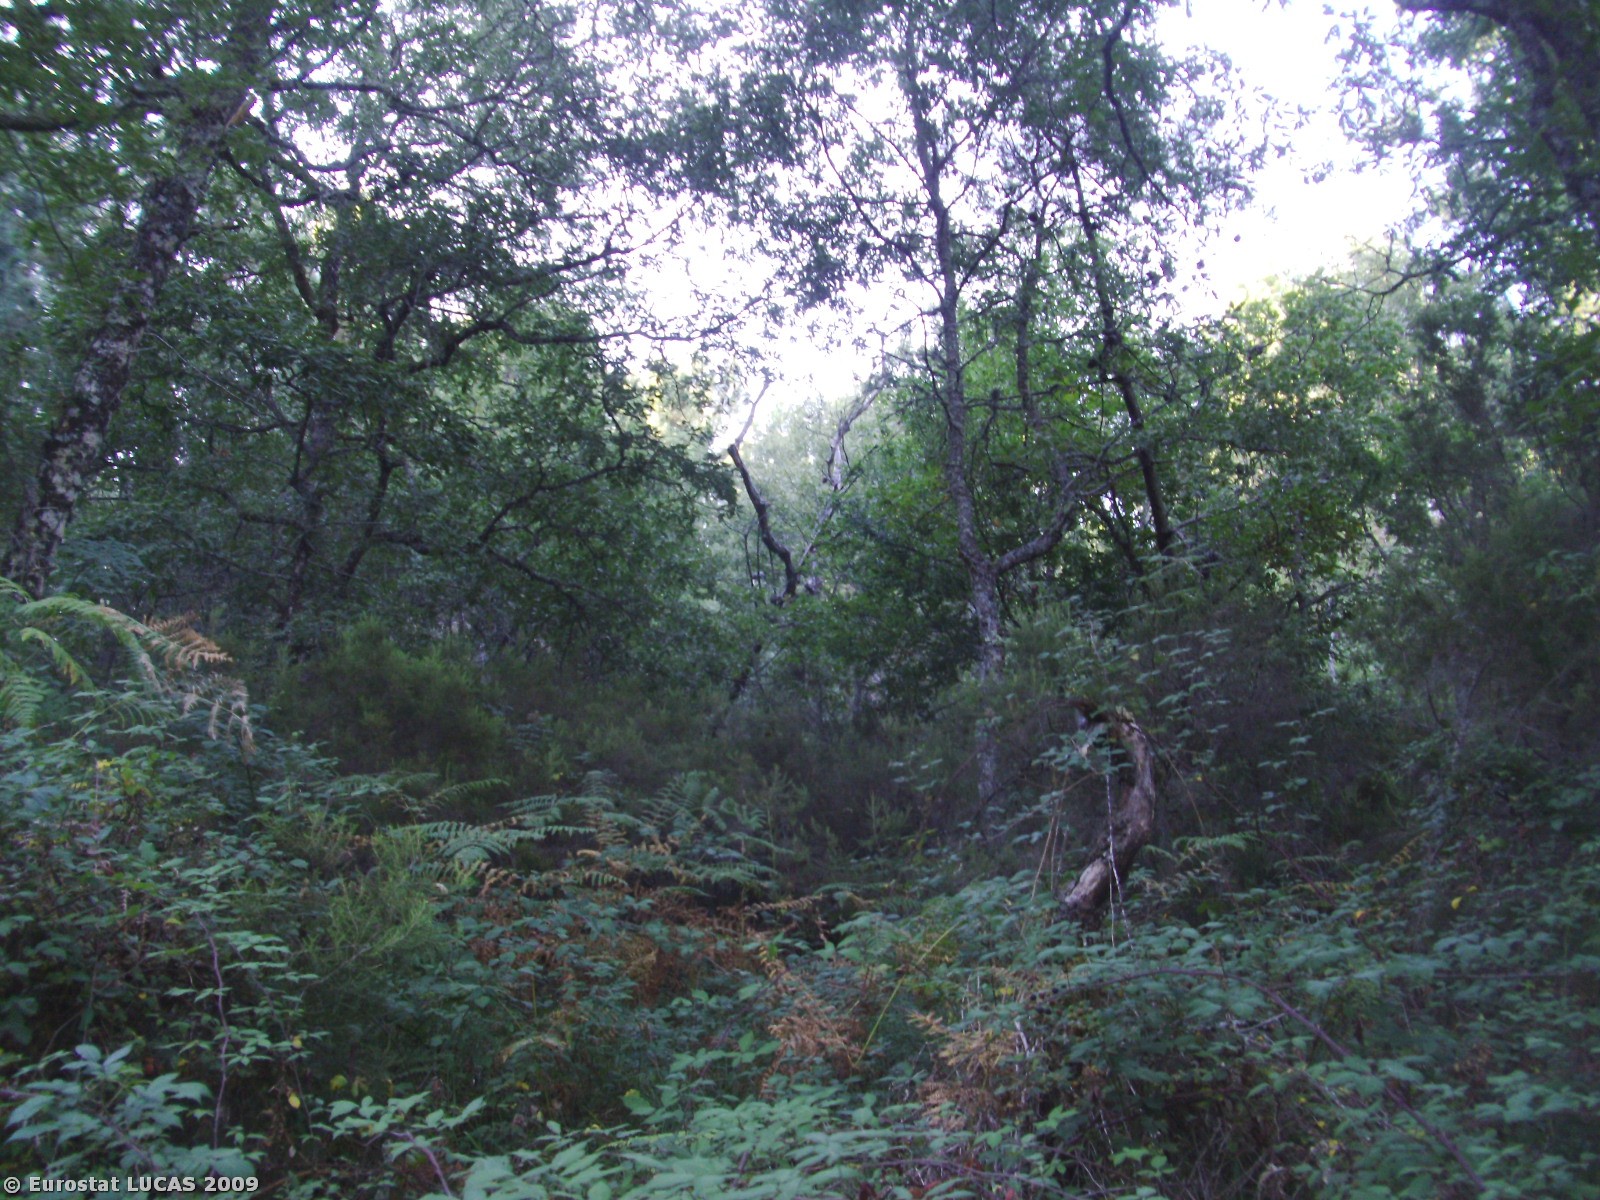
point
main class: Woodland
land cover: Mixed woodland
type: hemiboreal forest and nemoral coniferous forest and mixed broadleaved-coniferous forest
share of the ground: > 75 %
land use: Forestry
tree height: > 5 m
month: August
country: PT
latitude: 41.2944
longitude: -7.8428
